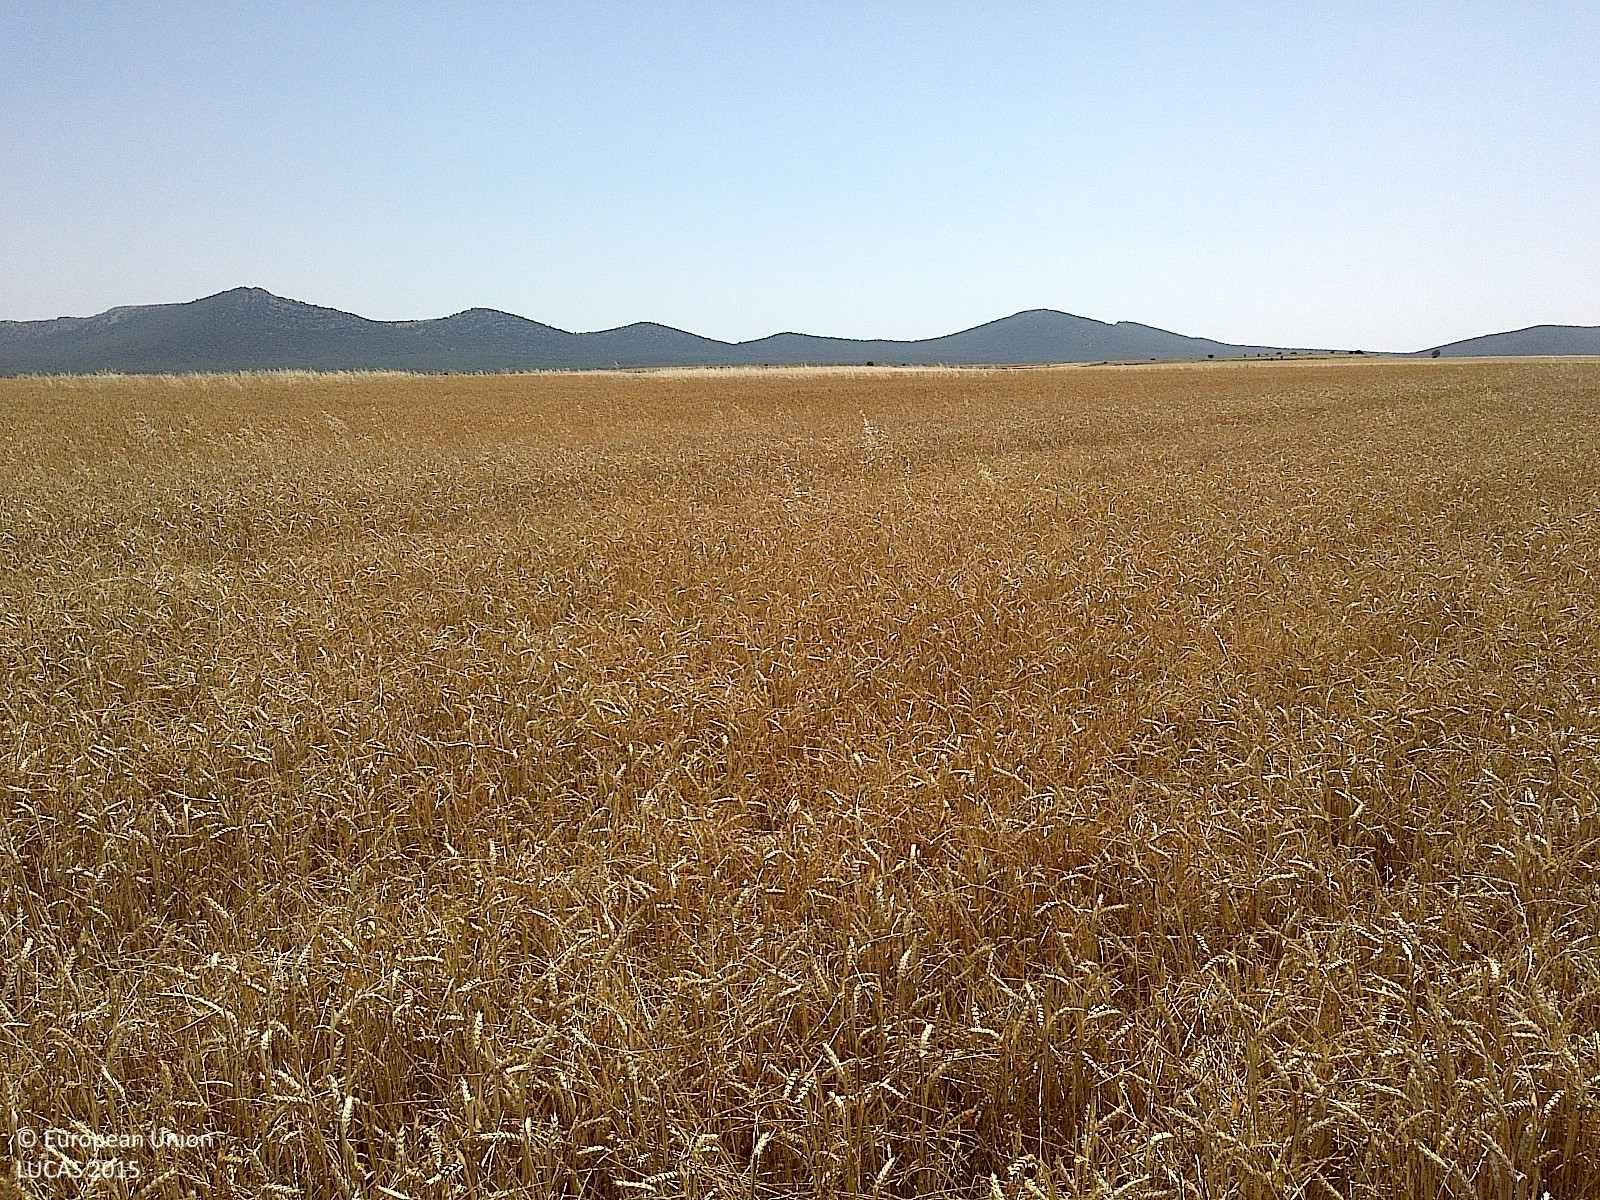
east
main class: Cropland
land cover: Common wheat
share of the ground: > 75 %
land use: Agriculture (excluding fallow land and kitchen gardens)
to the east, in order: Common wheat; Other bare soil
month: July
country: ES
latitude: 41.5928
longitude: -2.1371
